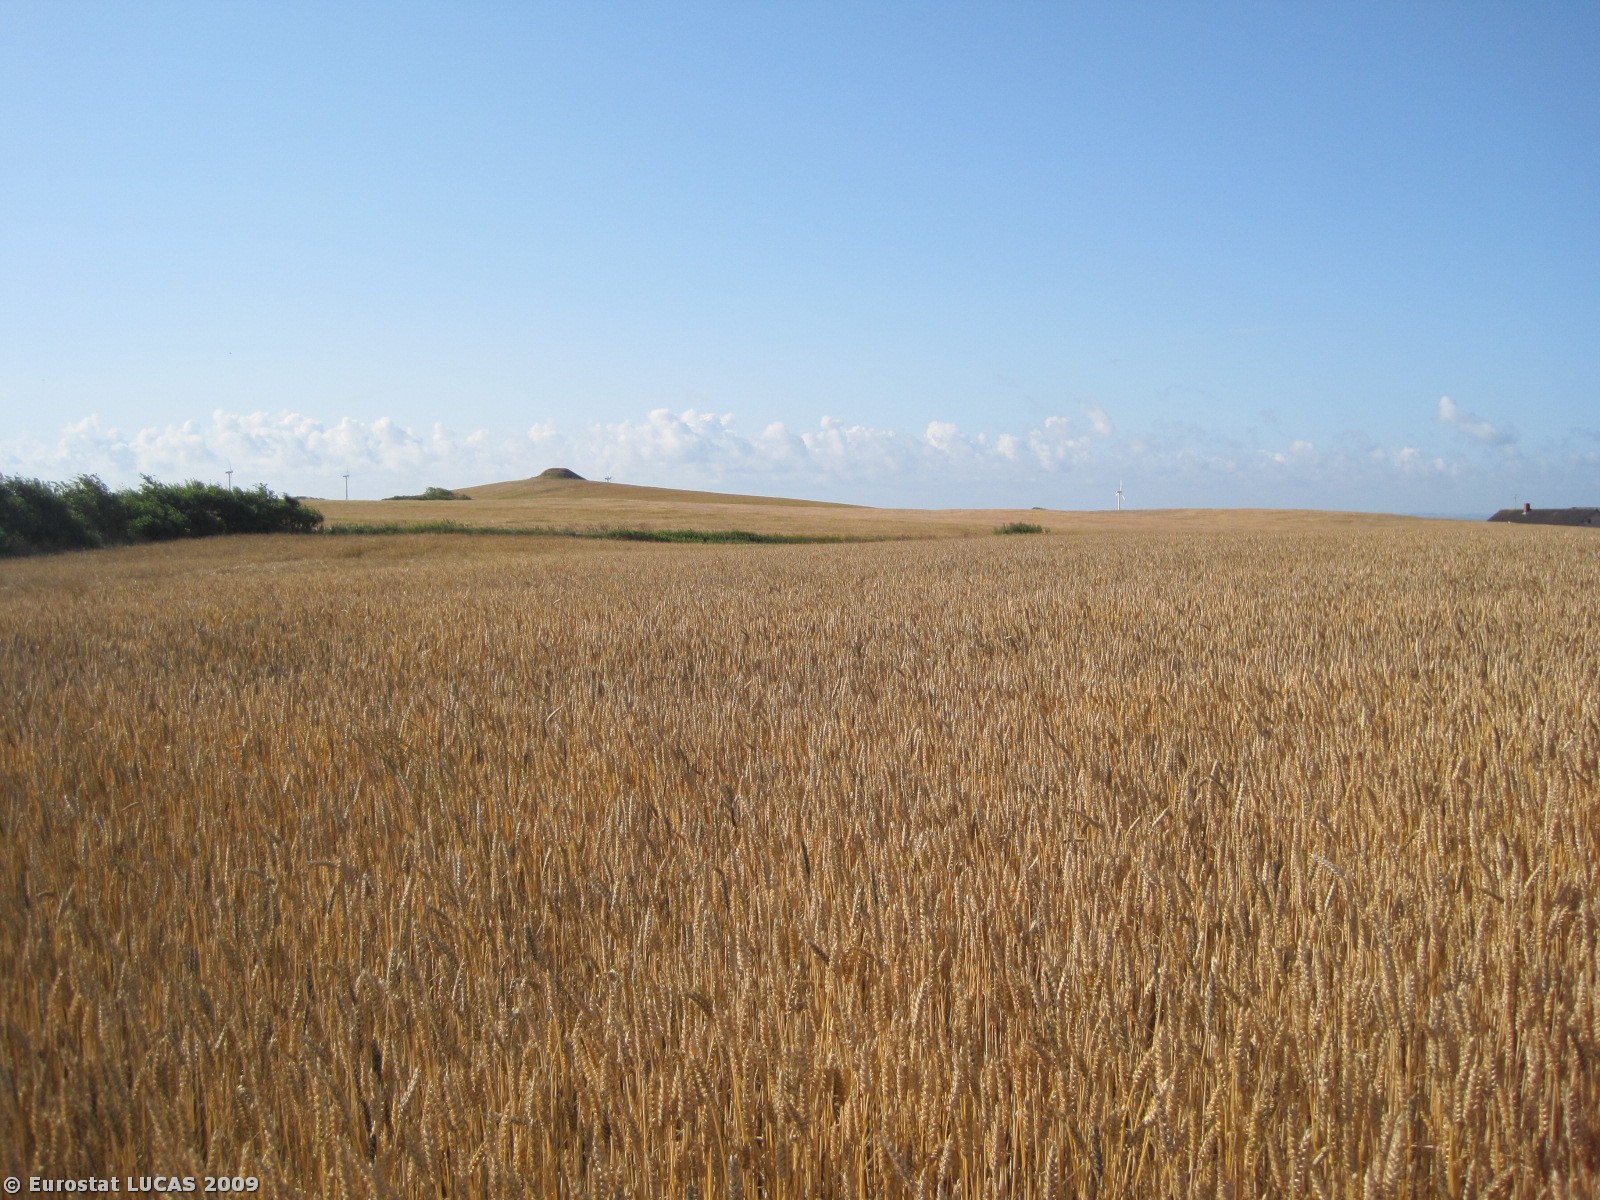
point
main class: Cropland
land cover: Common wheat
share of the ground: > 75 %
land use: Agriculture (excluding fallow land and kitchen gardens)
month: July
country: DK
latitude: 56.7341
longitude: 8.3185
